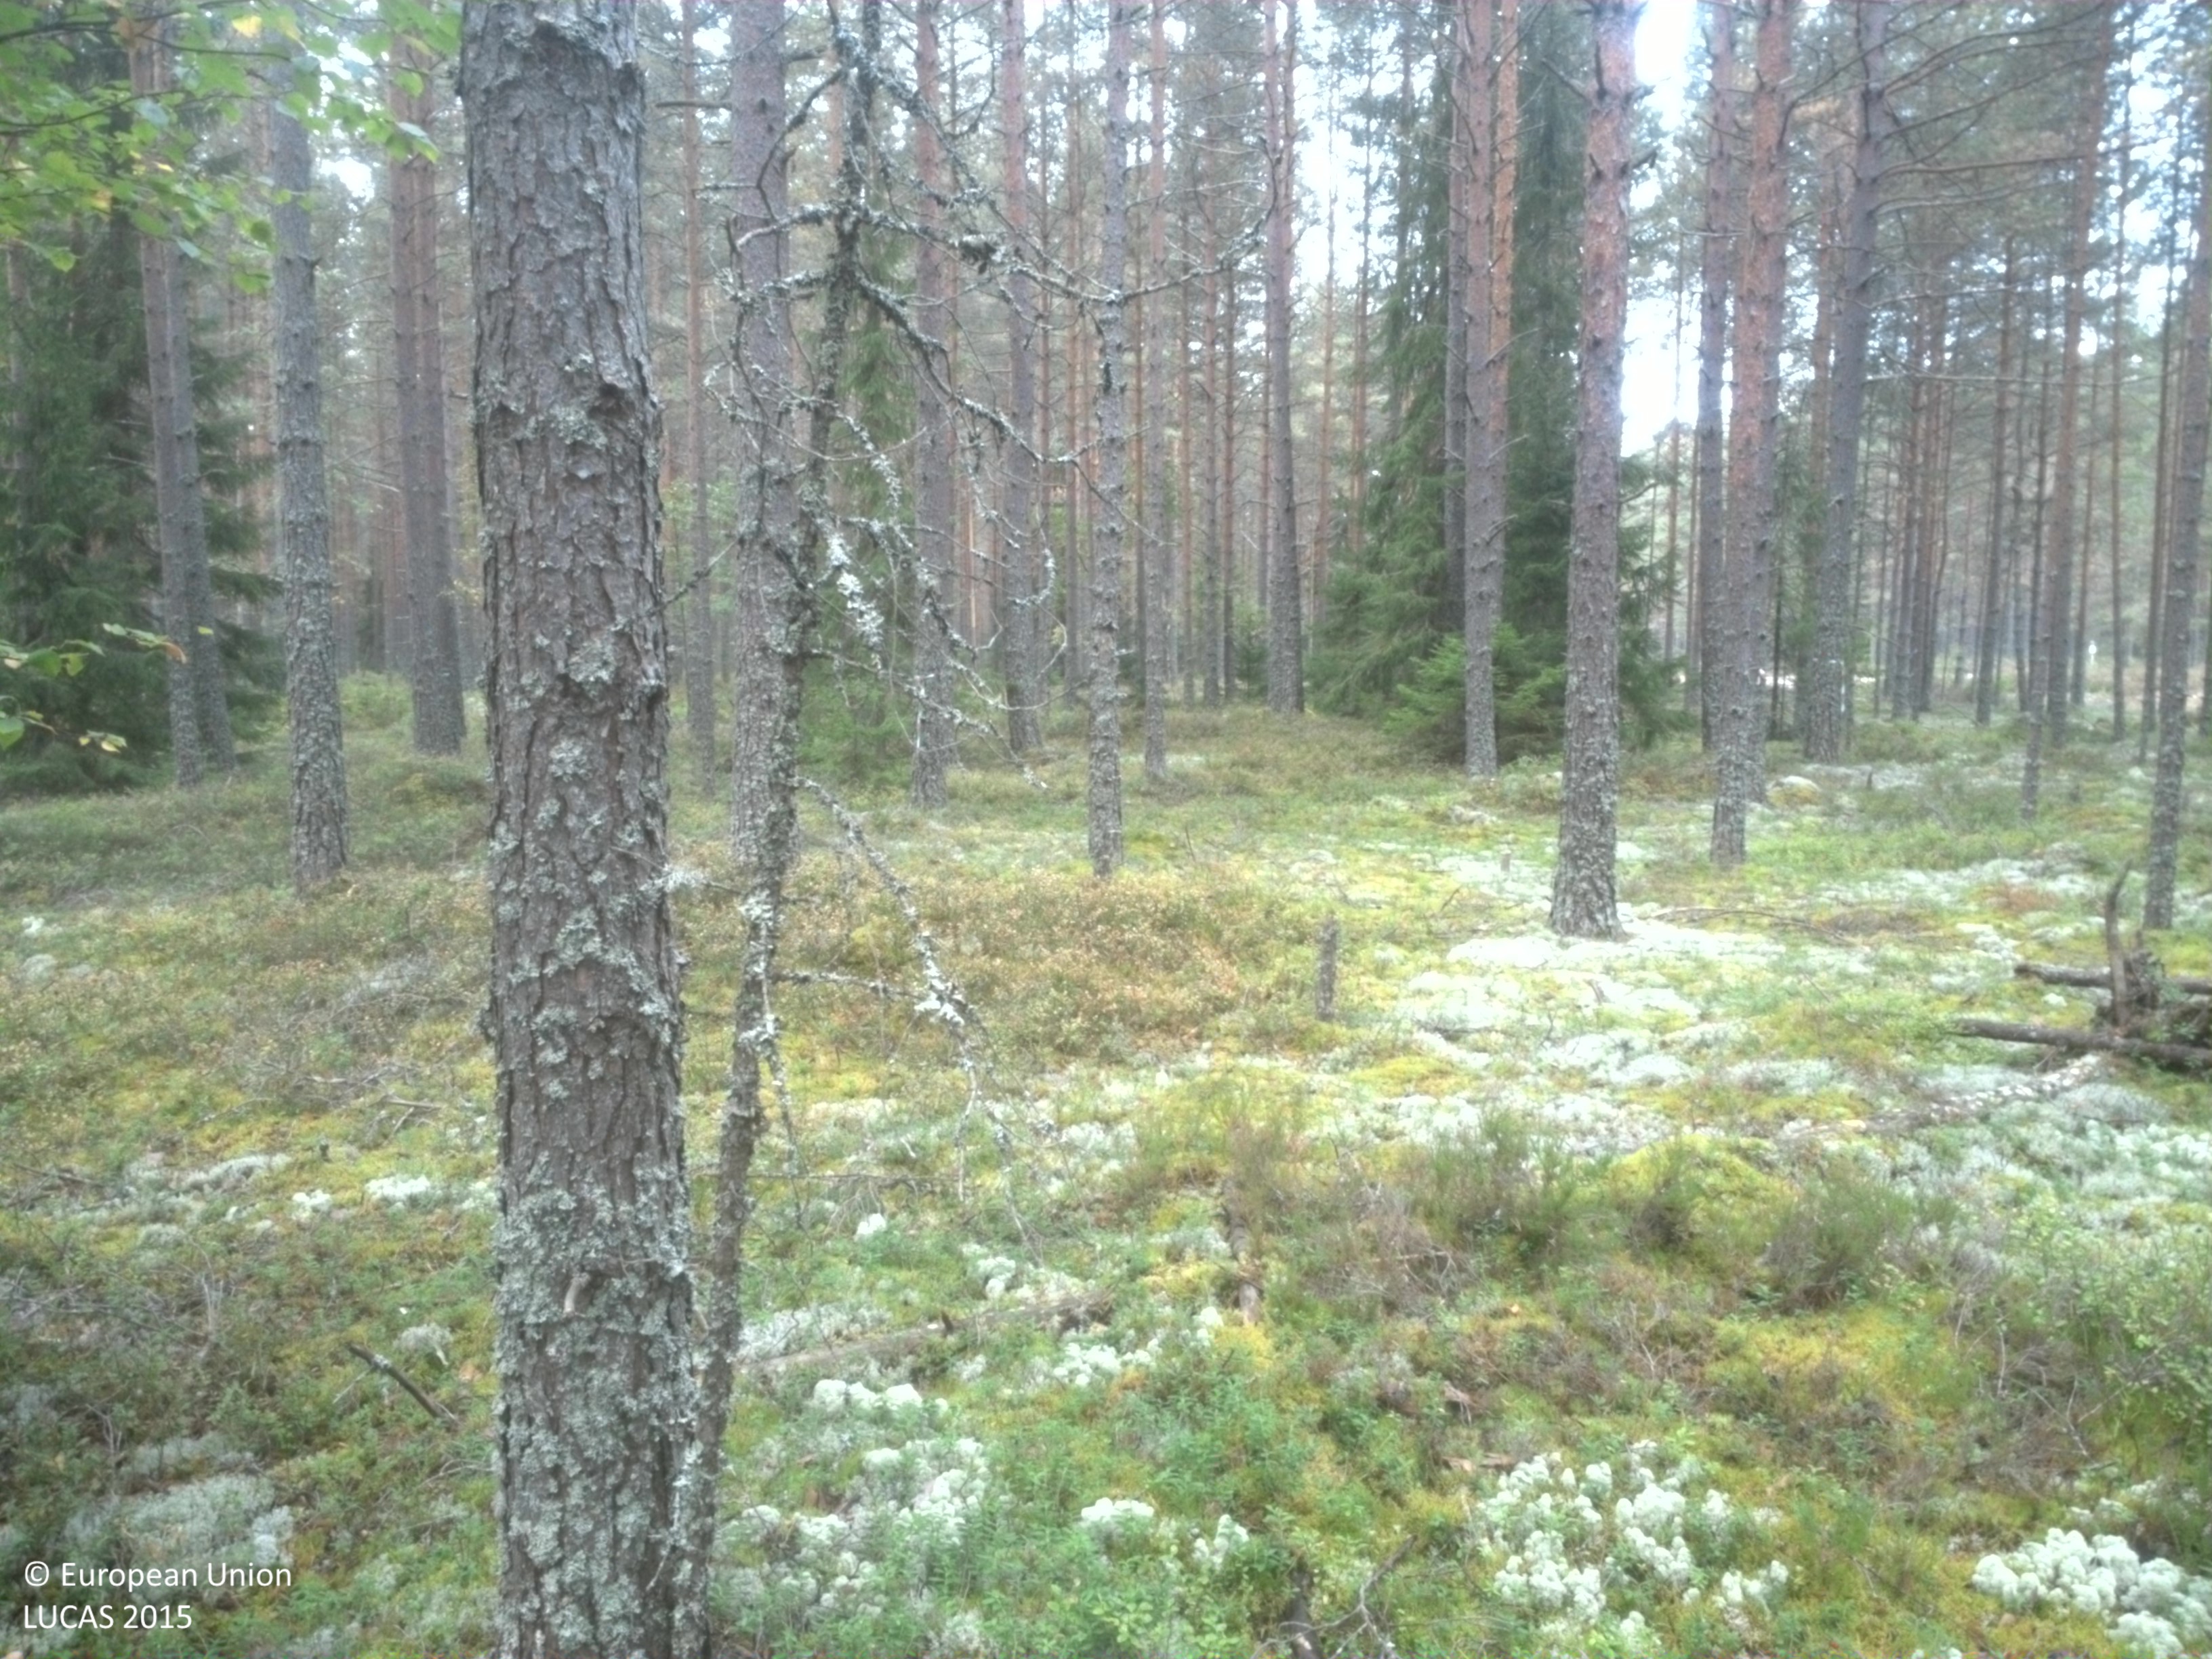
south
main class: Woodland
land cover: Pine dominated coniferous woodland
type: boreal forest
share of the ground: 50 - 75 %
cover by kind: coniferous forest trees 70 %, lichens and mosses 20 %, shrubs 10 %
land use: Forestry
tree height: > 5 m
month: September
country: SE
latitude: 59.8028
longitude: 15.4978
